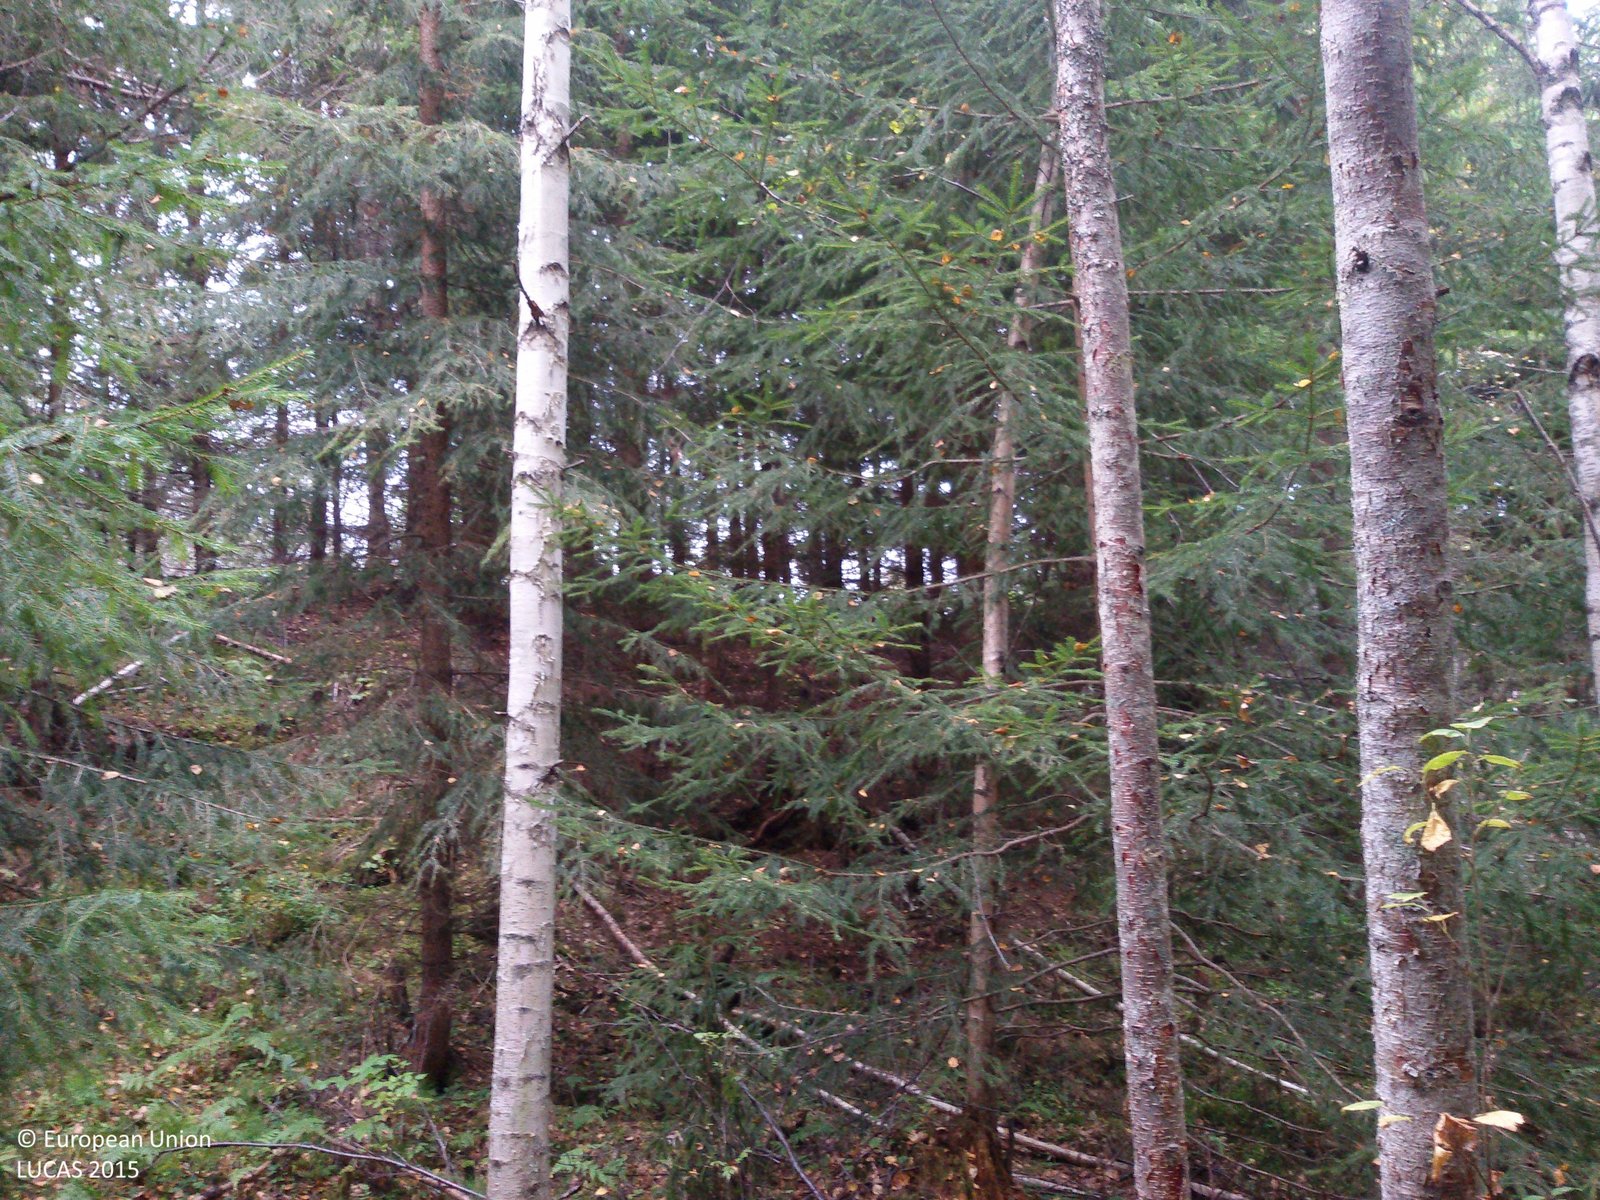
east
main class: Woodland
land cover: Spruce dominated mixed woodland
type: boreal forest
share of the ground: > 75 %
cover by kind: coniferous forest trees 50 %, broadleaved forest trees 30 %, herbaceous plants 10 %, lichens and mosses 10 %
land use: Forestry
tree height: > 5 m
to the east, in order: Spruce dominated mixed woodland; Tracks; Shrubland with sparse tree cover; Spontaneously vegetated surfaces; Tracks; Spontaneously vegetated surfaces; Electric lines; Pine dominated mixed woodland; Broadleaved woodland; Rivers and streams; Broadleaved woodland; Grass margins; Paved roads, cycling and walking lanes; Grass margins; Broadleaved woodland; Tracks
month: September
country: SE
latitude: 60.7072
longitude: 14.9526
